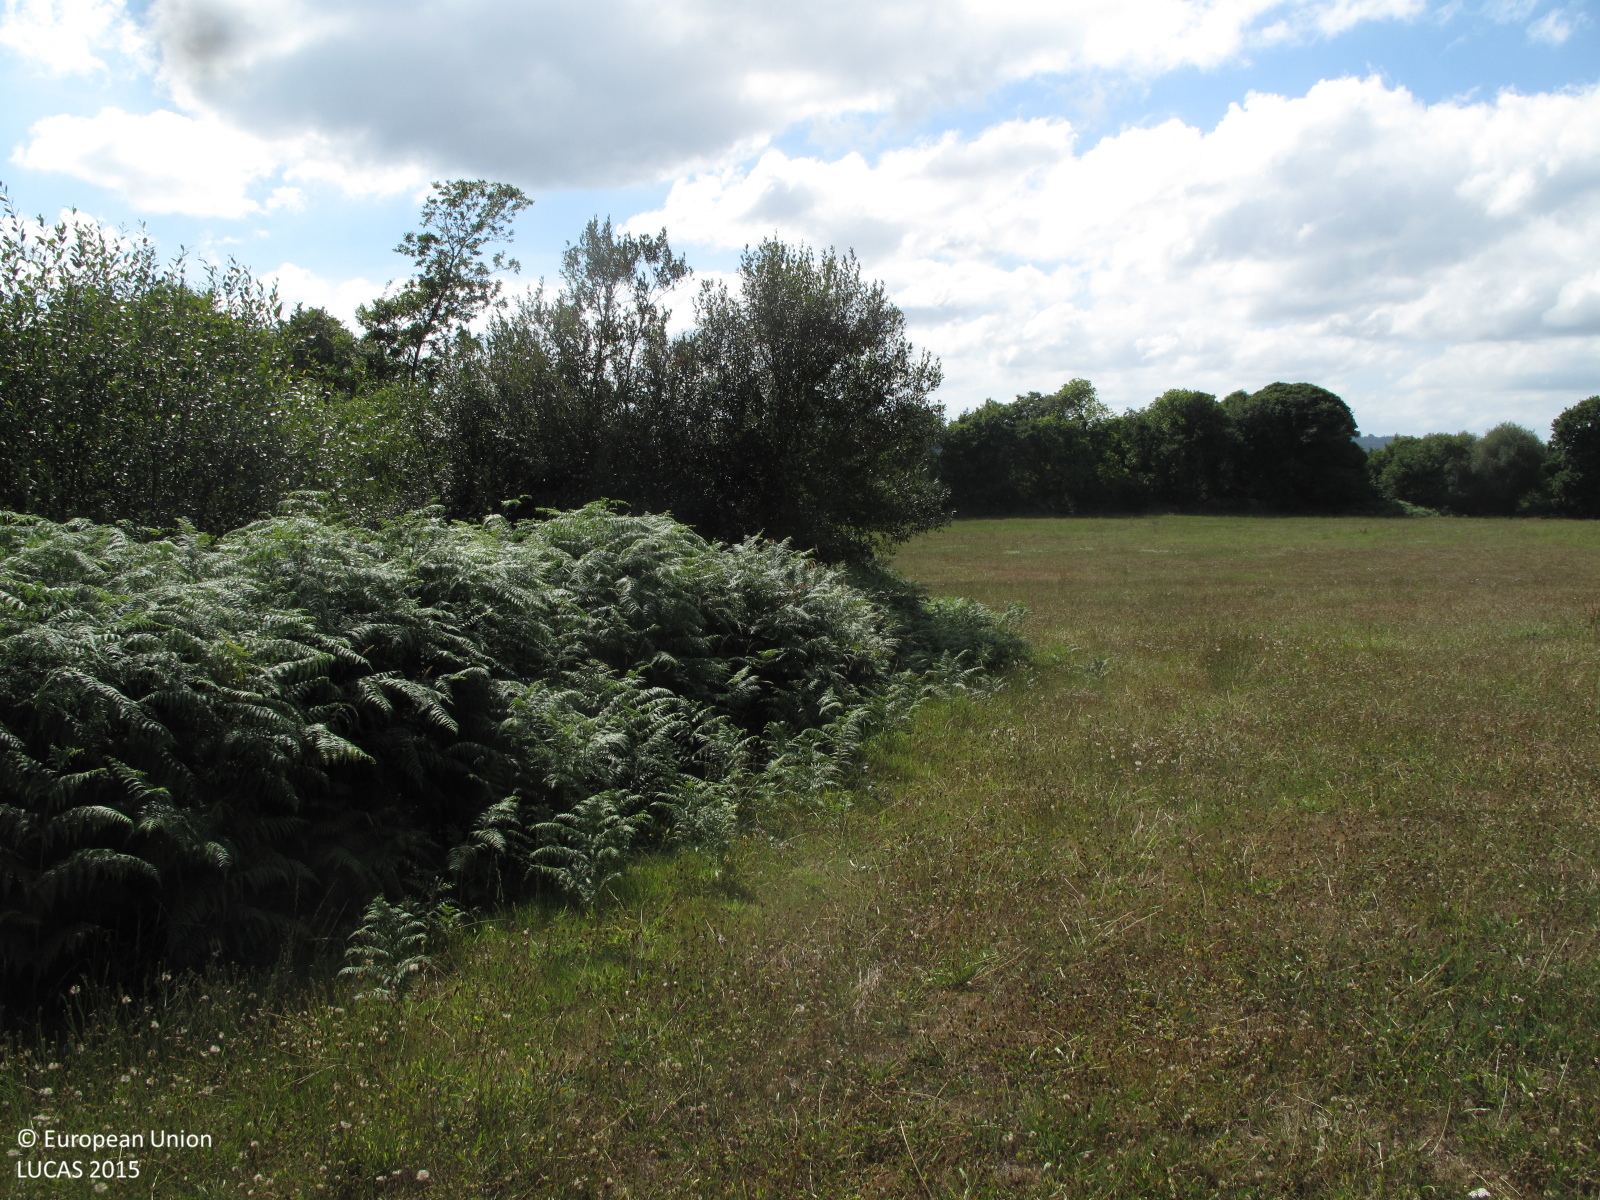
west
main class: Grassland
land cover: Grassland without tree/shrub cover
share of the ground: > 75 %
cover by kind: herbaceous plants 100 %
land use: Agriculture (excluding fallow land and kitchen gardens)
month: July
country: ES
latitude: 43.0987
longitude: -8.0681
